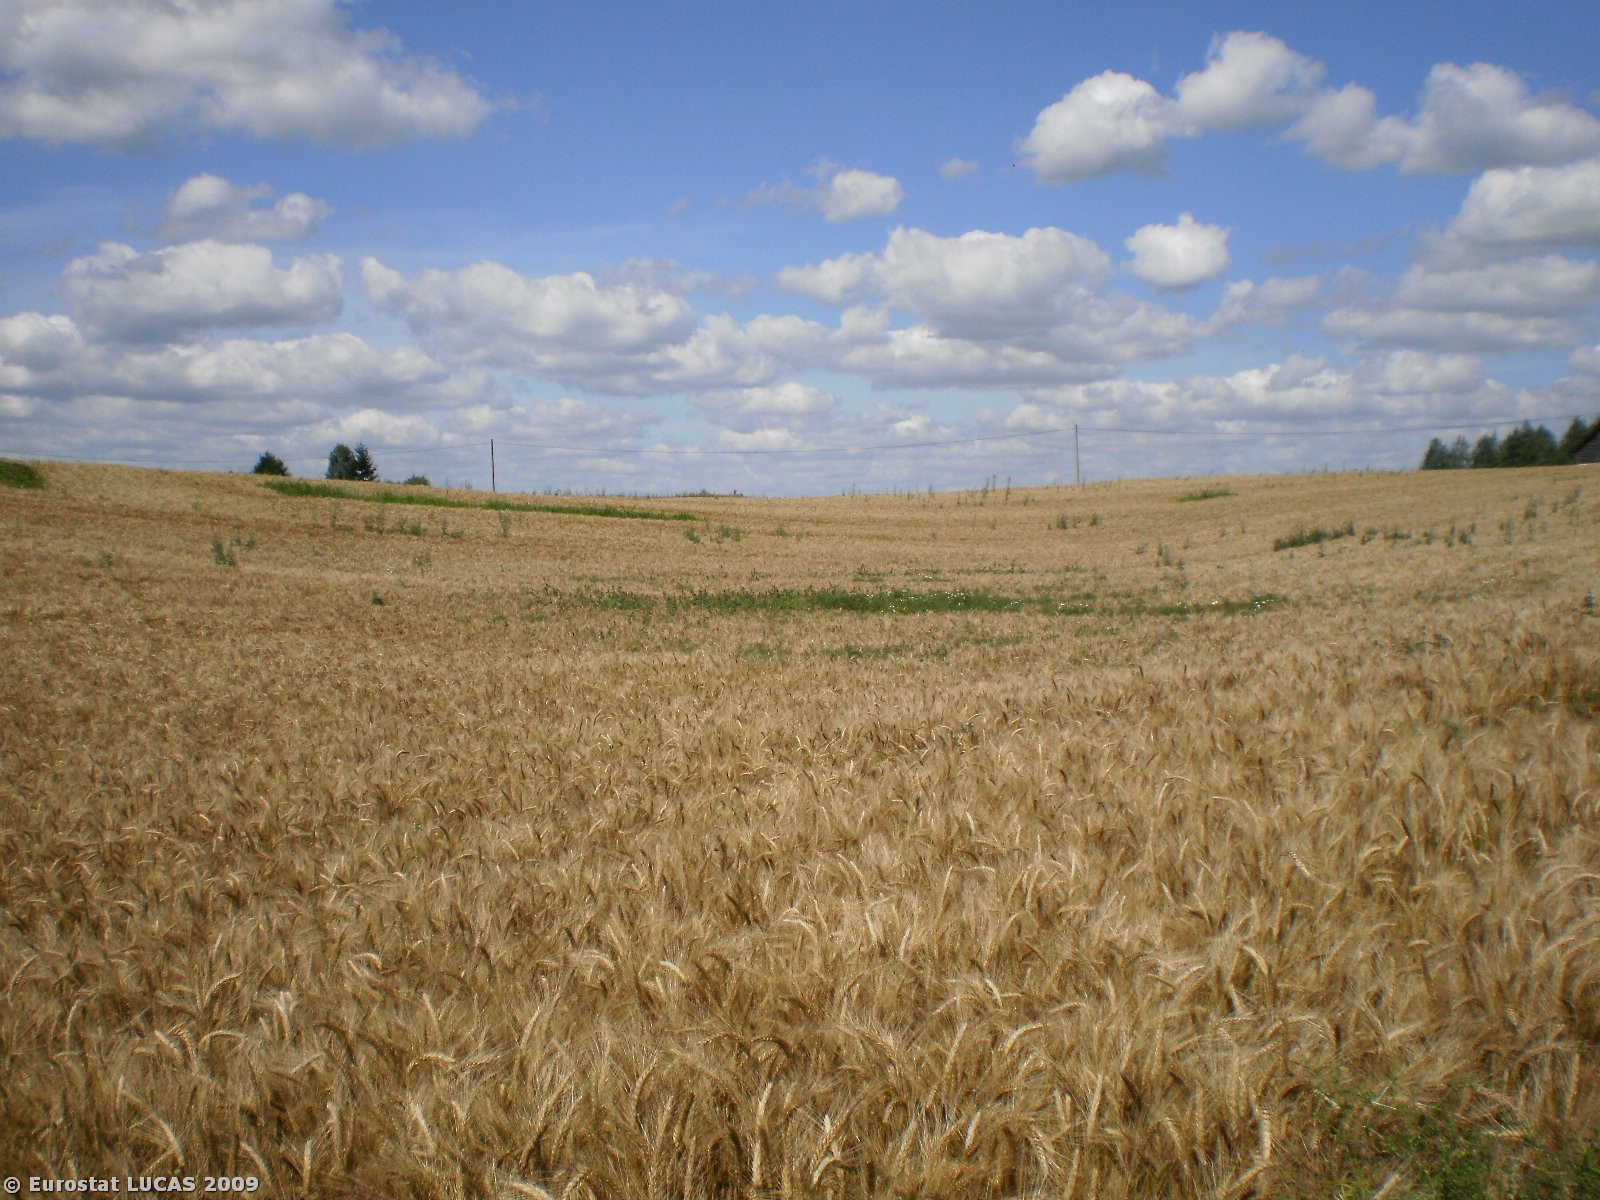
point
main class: Cropland
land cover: Triticale
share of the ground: > 75 %
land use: Agriculture (excluding fallow land and kitchen gardens)
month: August
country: PL
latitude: 53.8803
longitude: 20.5796
